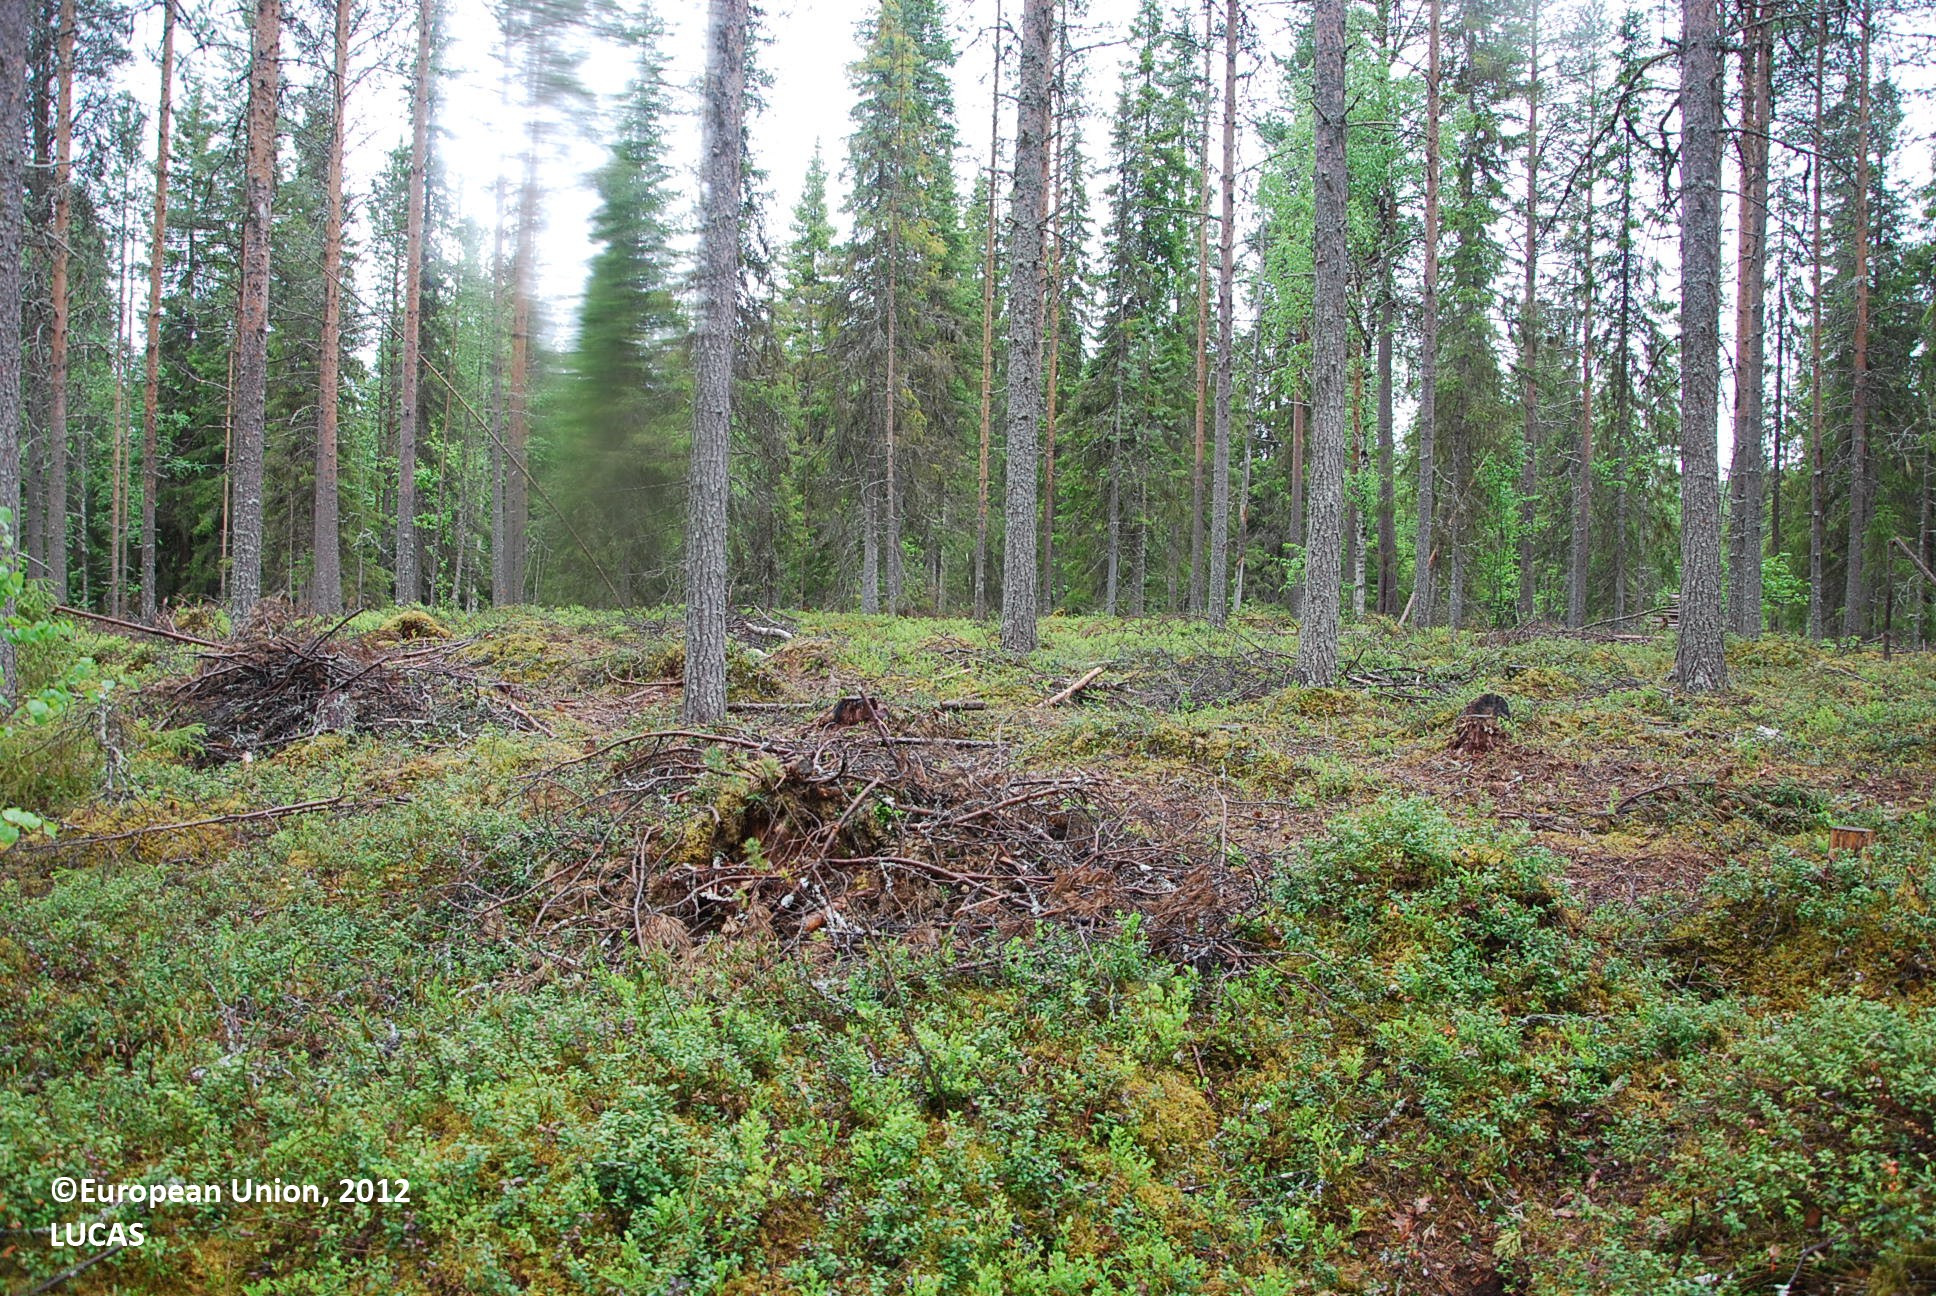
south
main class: Woodland
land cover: Other coniferous woodland
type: boreal forest
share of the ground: > 75 %
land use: Forestry
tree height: > 5 m
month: June
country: FI
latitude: 66.2647
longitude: 26.9565
